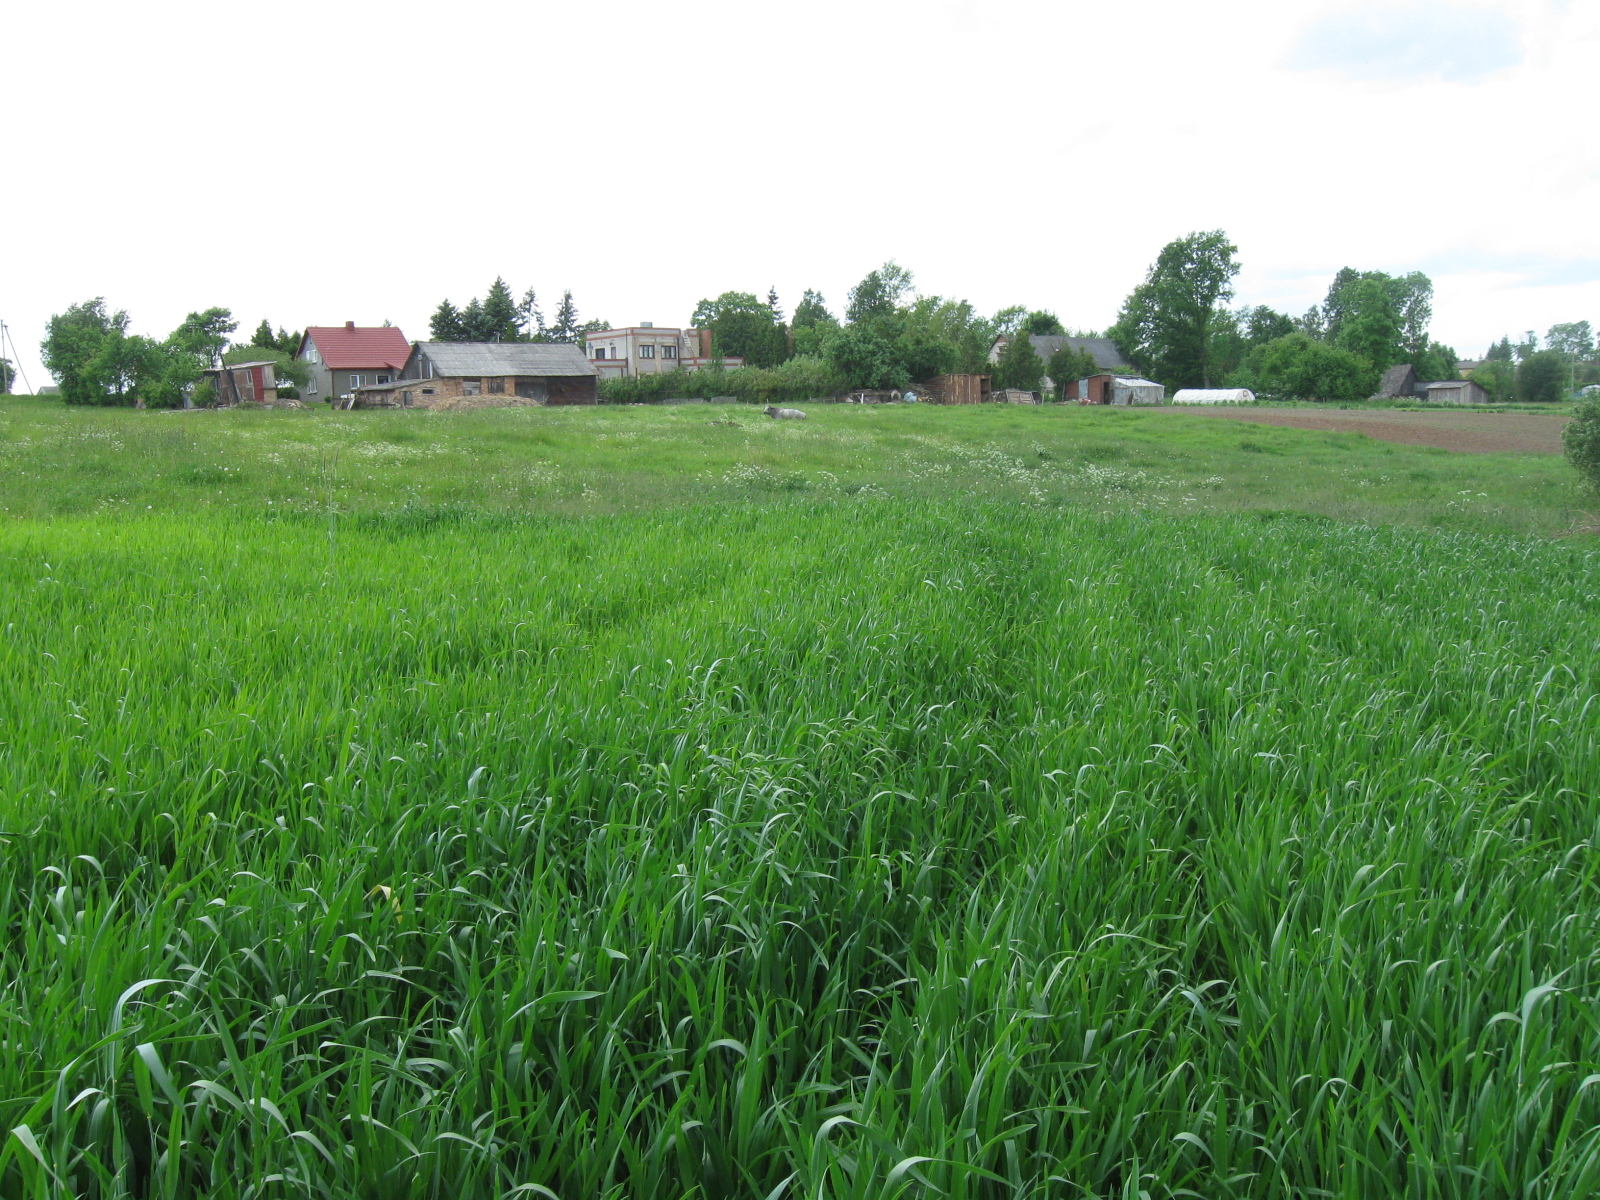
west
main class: Cropland
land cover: Common wheat
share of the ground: > 75 %
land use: Agriculture (excluding fallow land and kitchen gardens)
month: June
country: LT
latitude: 54.3419
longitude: 23.7935
